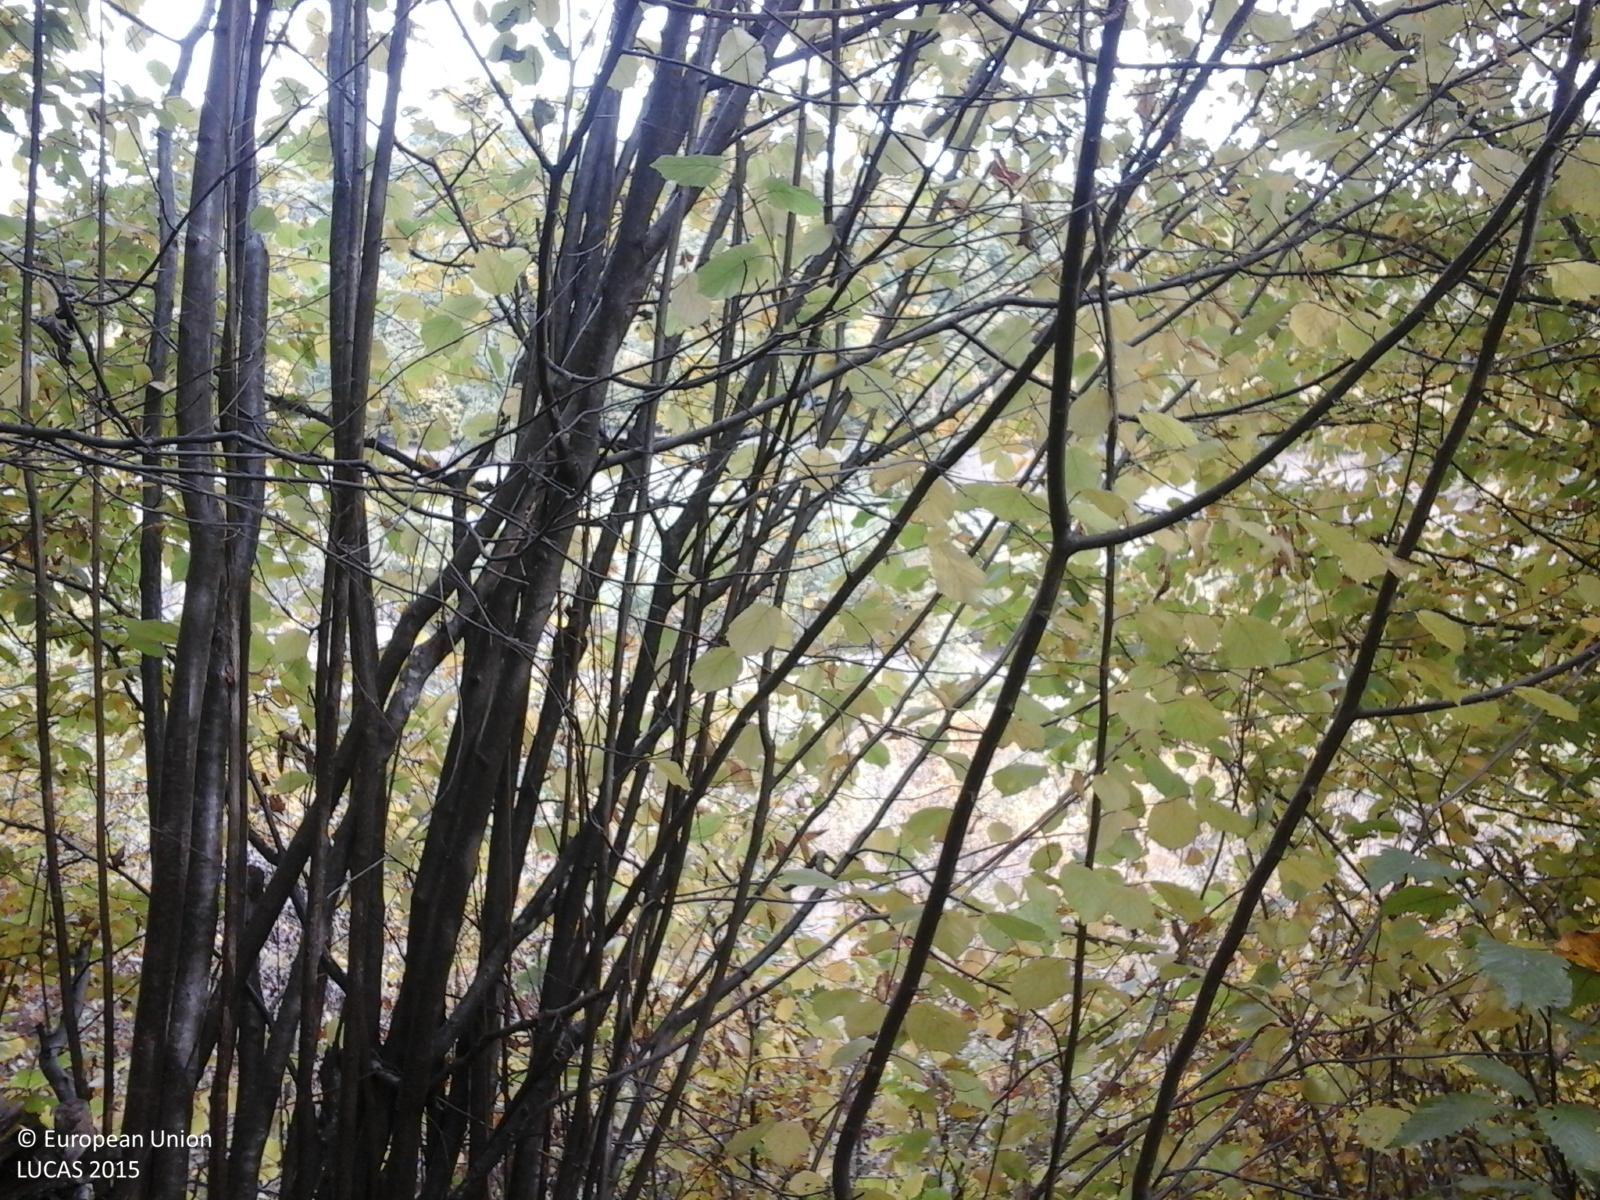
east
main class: Woodland
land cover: Broadleaved woodland
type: beech forest
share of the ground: > 75 %
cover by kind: broadleaved forest trees 100 %
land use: Forestry
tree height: > 5 m
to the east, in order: Broadleaved woodland; Grassland with sparse tree/shrub cover; Rivers and streams; Grassland with sparse tree/shrub cover; Tracks; Grassland without tree/shrub cover; Lines of trees; Rivers and streams; Lines of trees; Electric lines; Tracks; Grassland without tree/shrub cover; Tracks; Grassland without tree/shrub cover
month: October
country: RO
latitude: 46.4546
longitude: 25.4041
